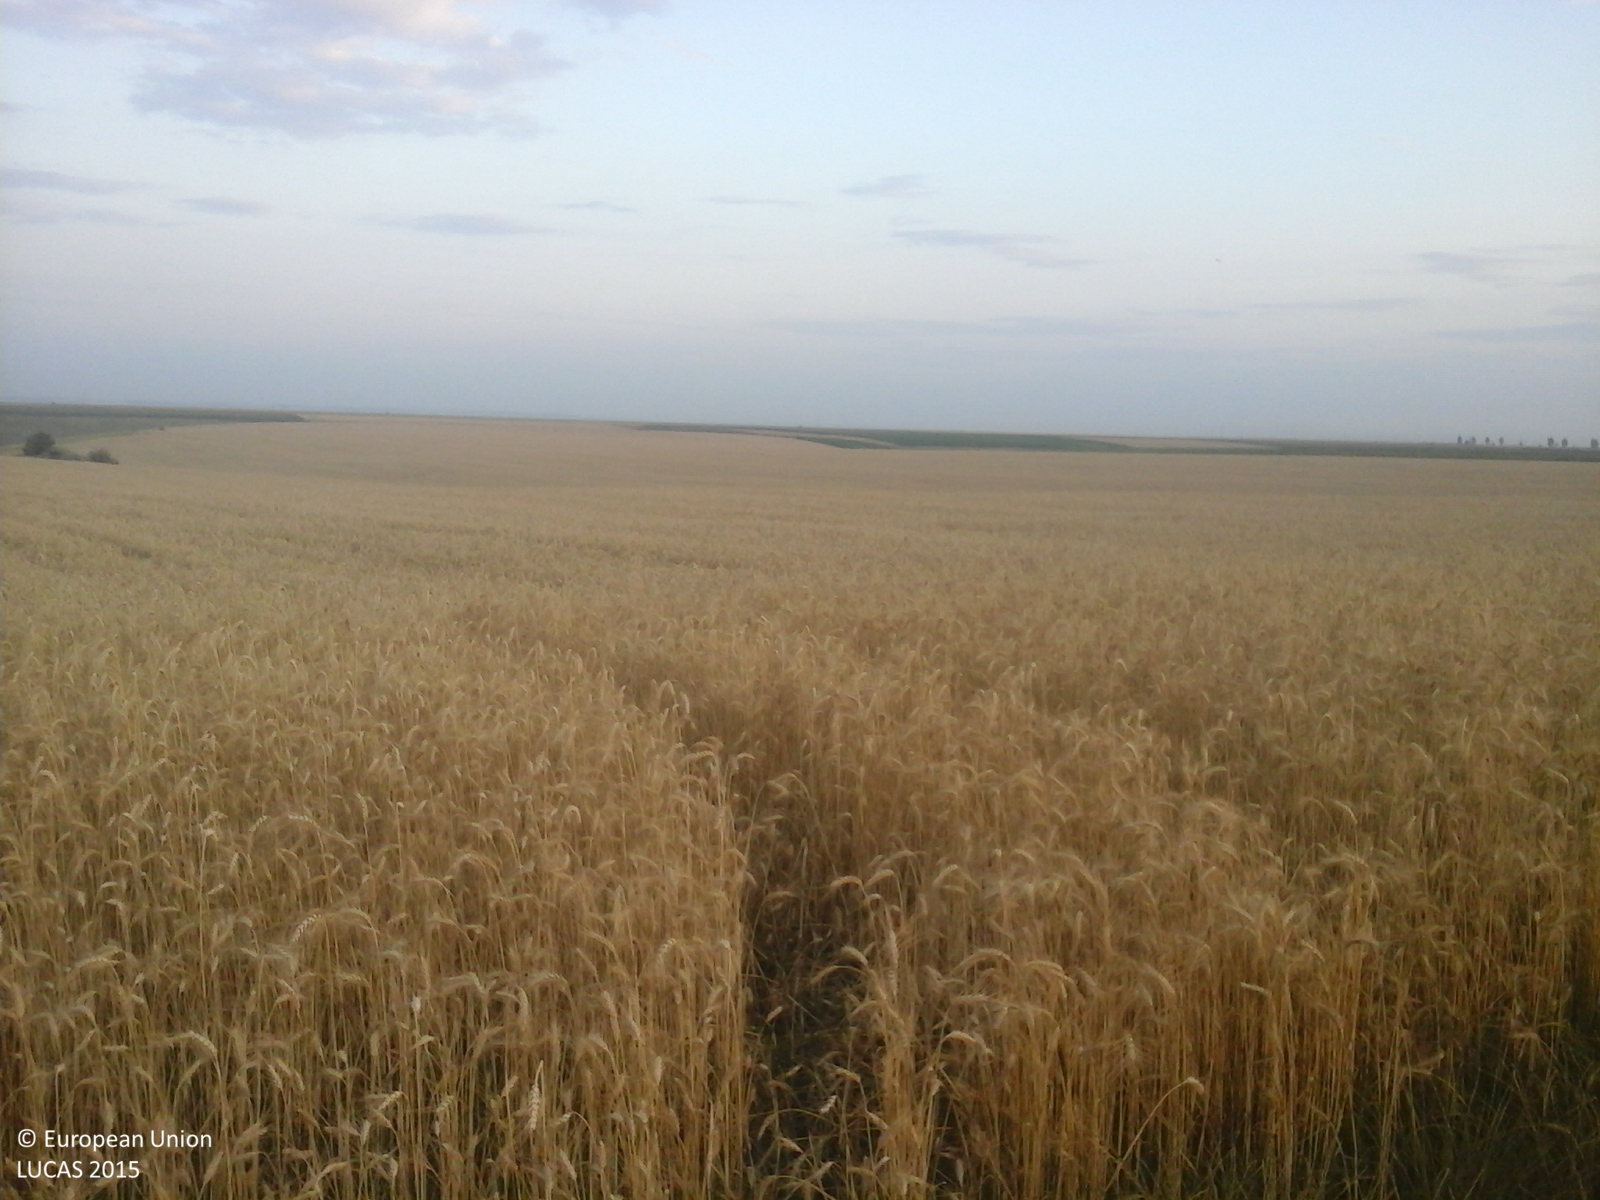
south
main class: Cropland
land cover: Common wheat
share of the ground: > 75 %
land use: Agriculture (excluding fallow land and kitchen gardens)
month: July
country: RO
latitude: 44.0069
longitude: 25.9493
